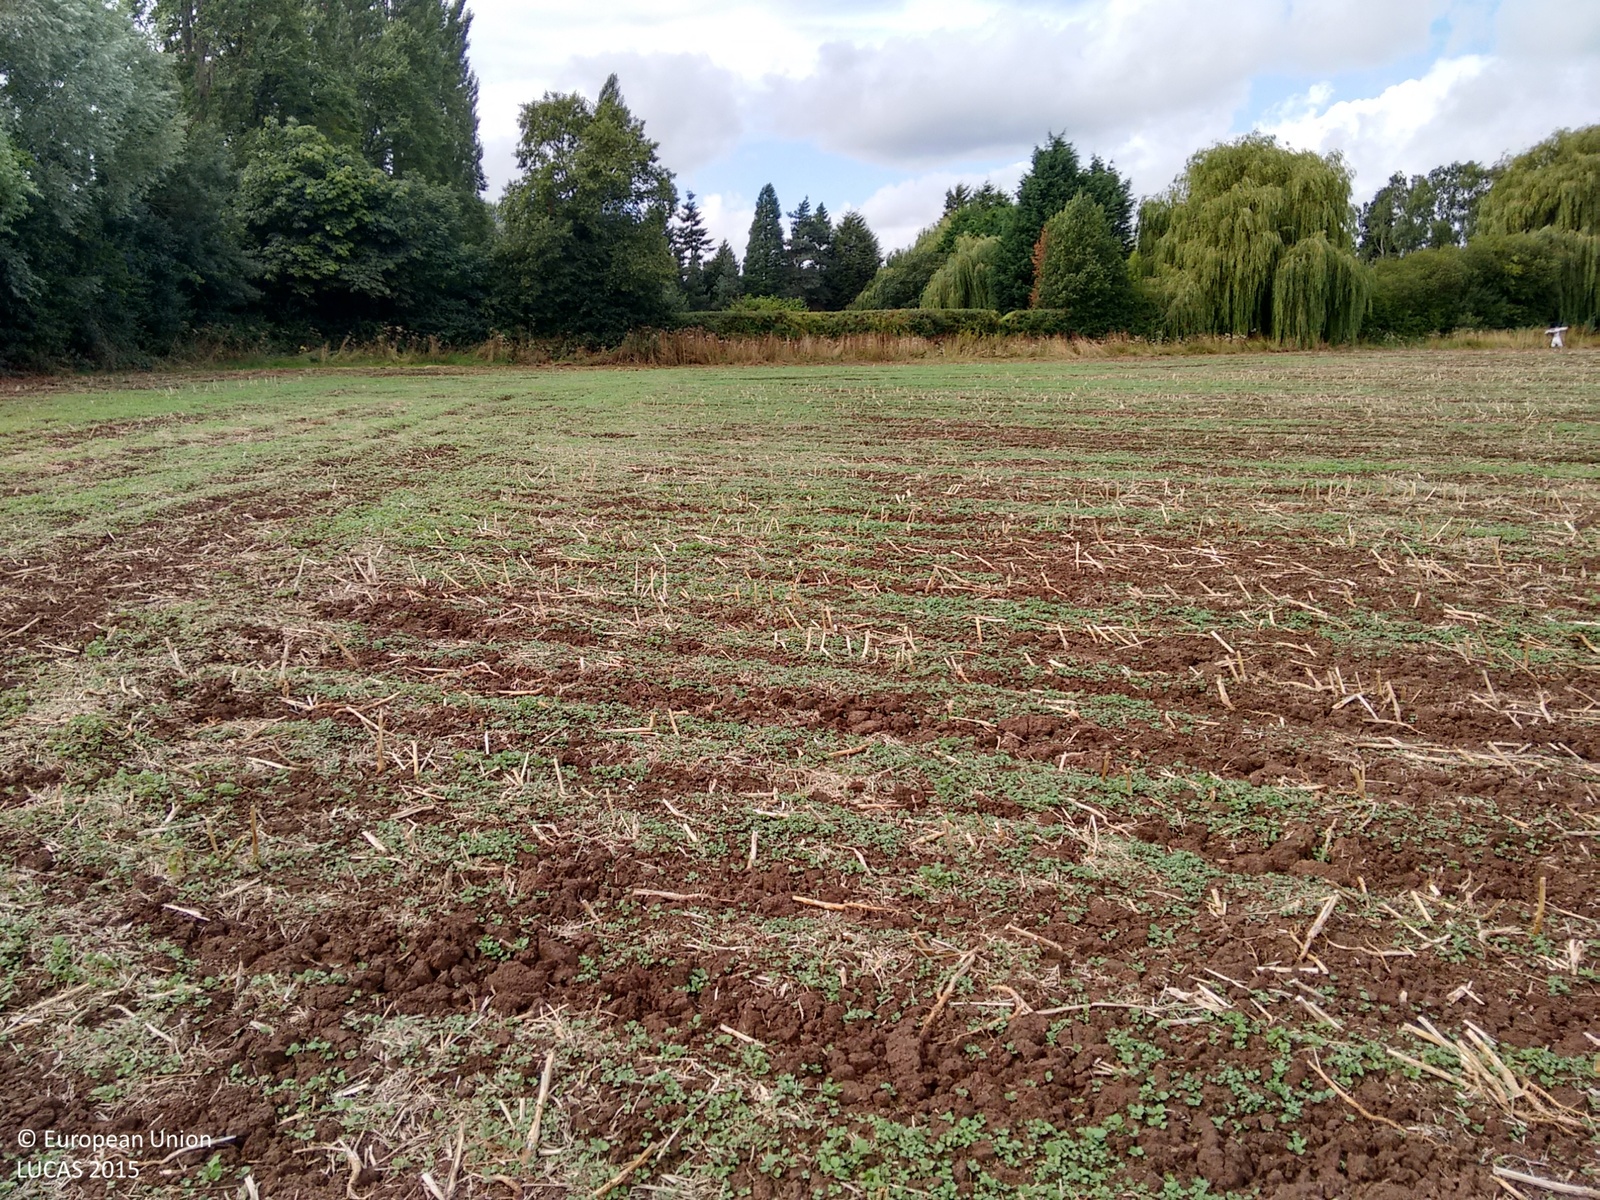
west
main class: Cropland
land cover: Rape and turnip rape
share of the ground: > 75 %
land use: Agriculture (excluding fallow land and kitchen gardens)
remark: Harvested field
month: August
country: GB
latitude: 52.8007
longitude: -1.2757
